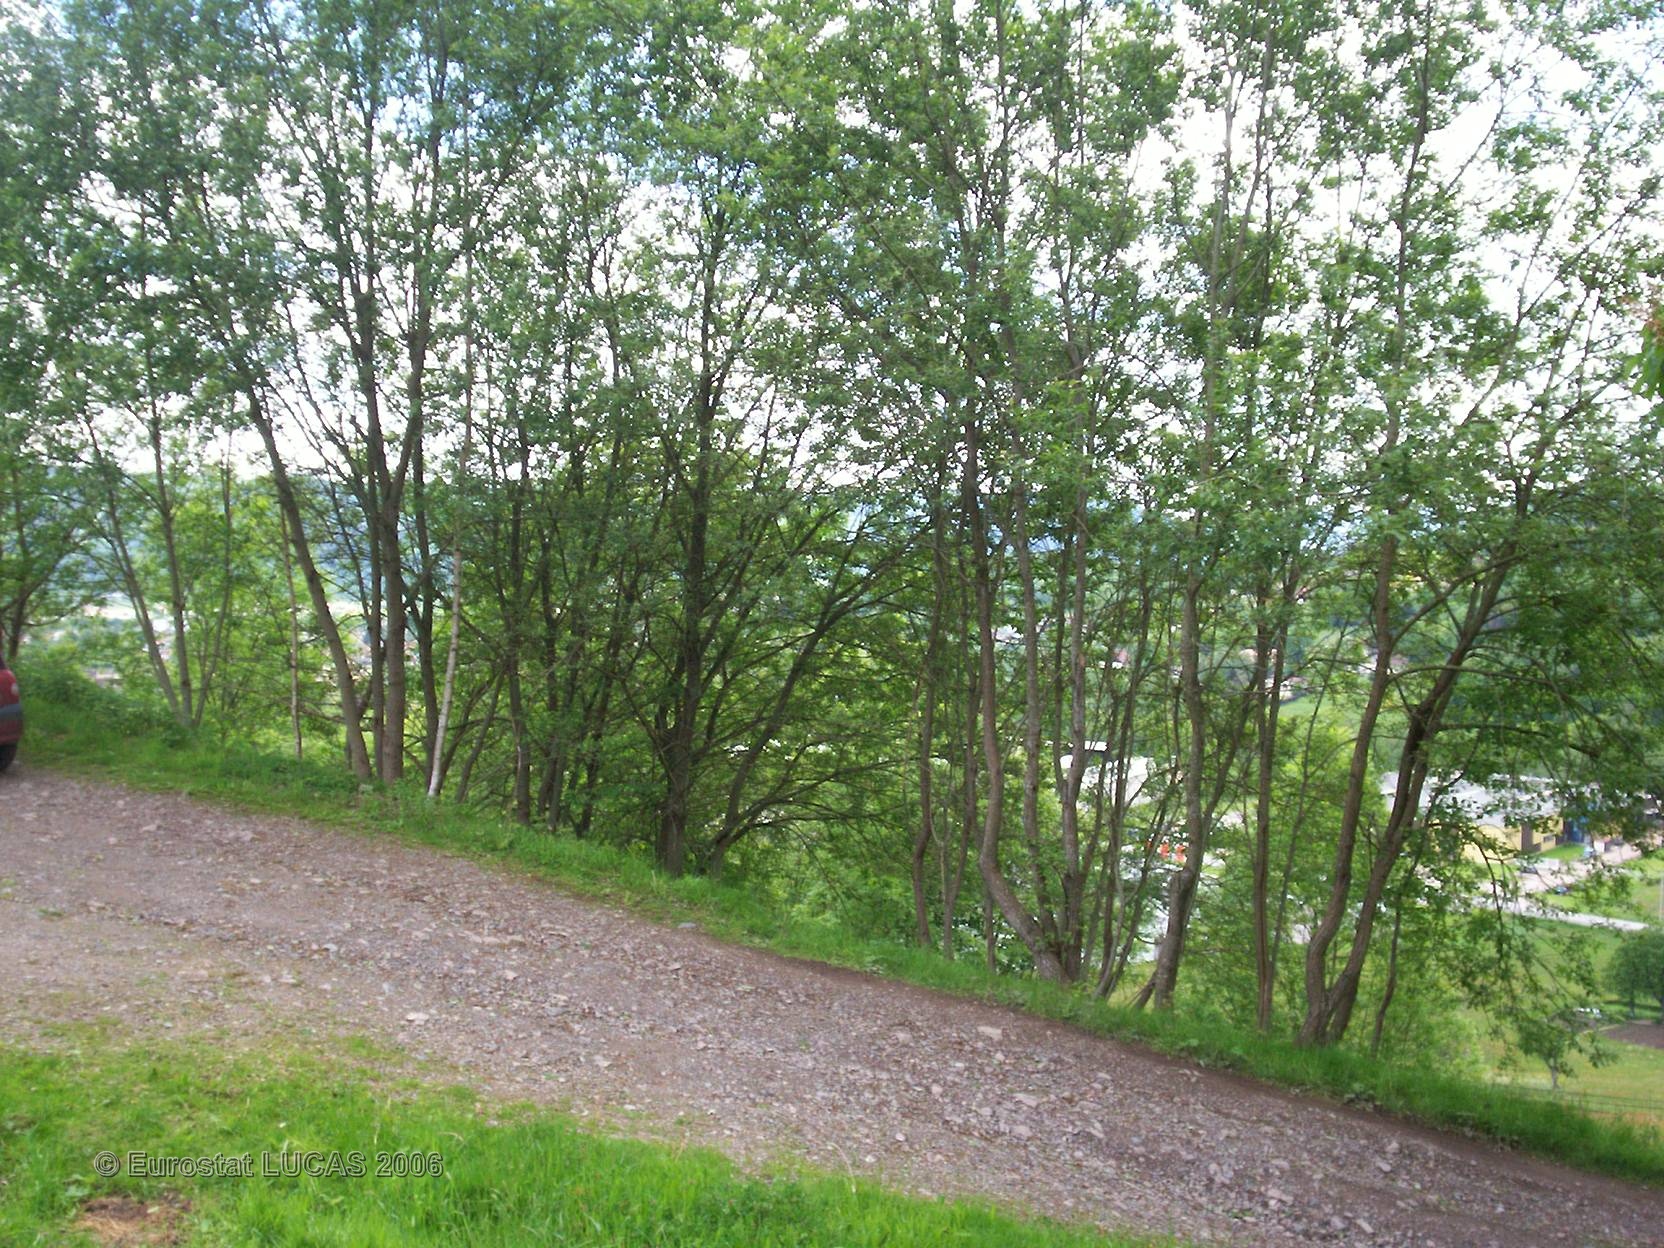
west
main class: Grassland
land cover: Grassland with sparse tree/shrub cover
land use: Agriculture (excluding fallow land and kitchen gardens)
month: June
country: FR
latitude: 47.8883
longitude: 6.7781
